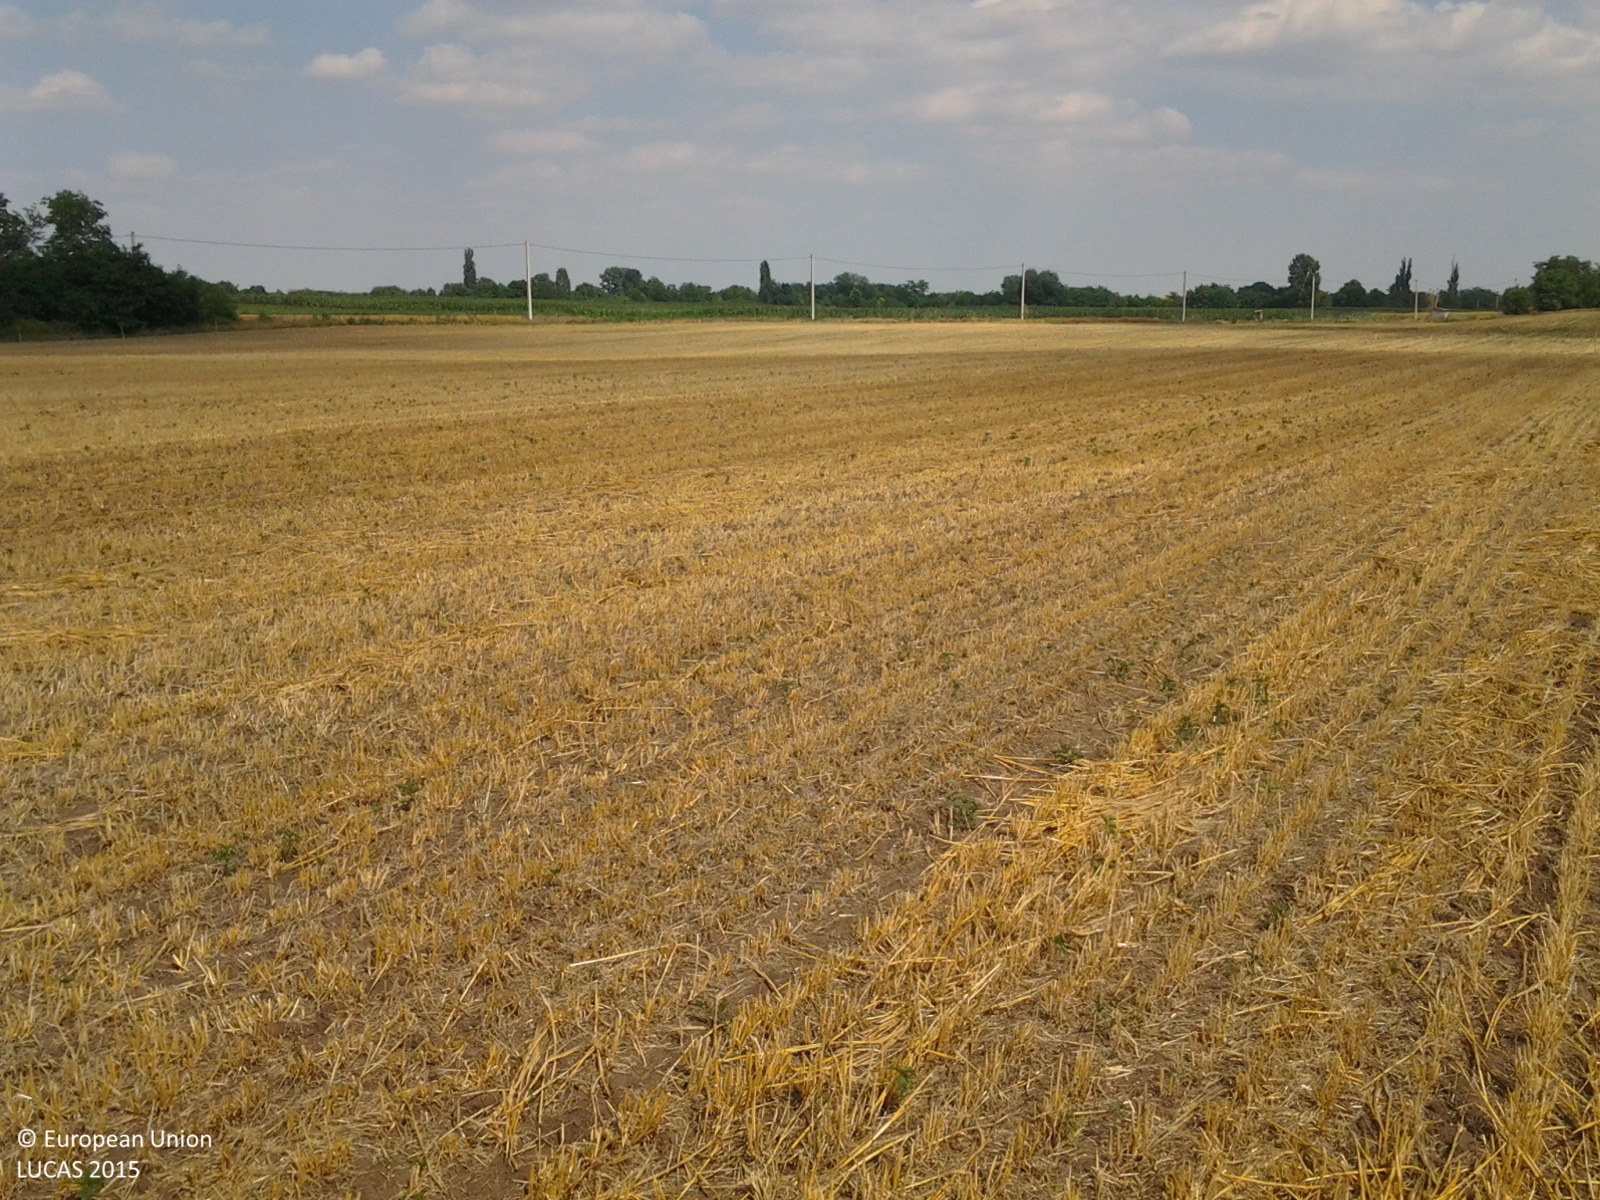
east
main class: Cropland
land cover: Barley
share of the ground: > 75 %
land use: Agriculture (excluding fallow land and kitchen gardens)
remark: Harvested field
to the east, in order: Barley; Electric lines; Shruby margins; Tracks; Potatoes; Maize
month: July
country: HU
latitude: 47.4952
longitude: 19.8071
